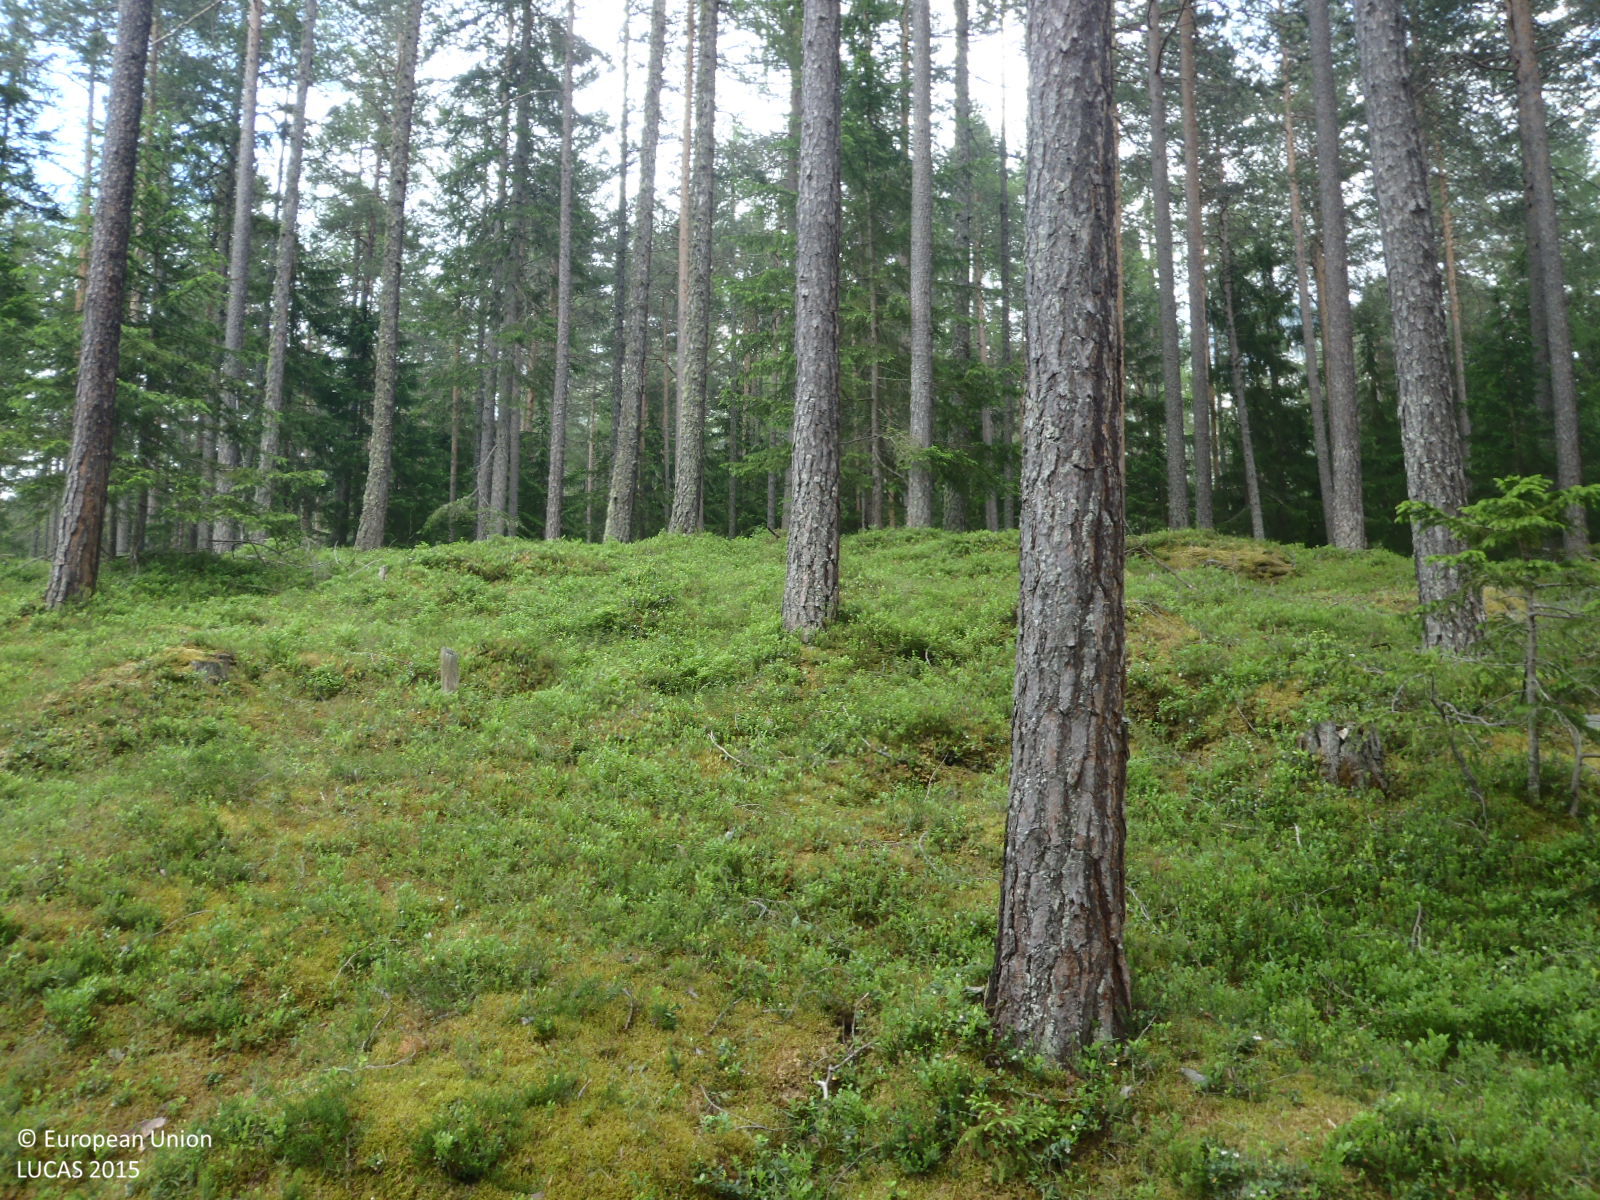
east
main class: Woodland
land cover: Pine dominated coniferous woodland
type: alpine coniferous forest
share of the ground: > 75 %
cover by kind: coniferous forest trees 70 %, shrubs 20 %, herbaceous plants 5 %, lichens and mosses 5 %
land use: Forestry
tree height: > 5 m
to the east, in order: Pine dominated coniferous woodland; Other coniferous woodland
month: June
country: AT
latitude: 47.1035
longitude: 10.9346
